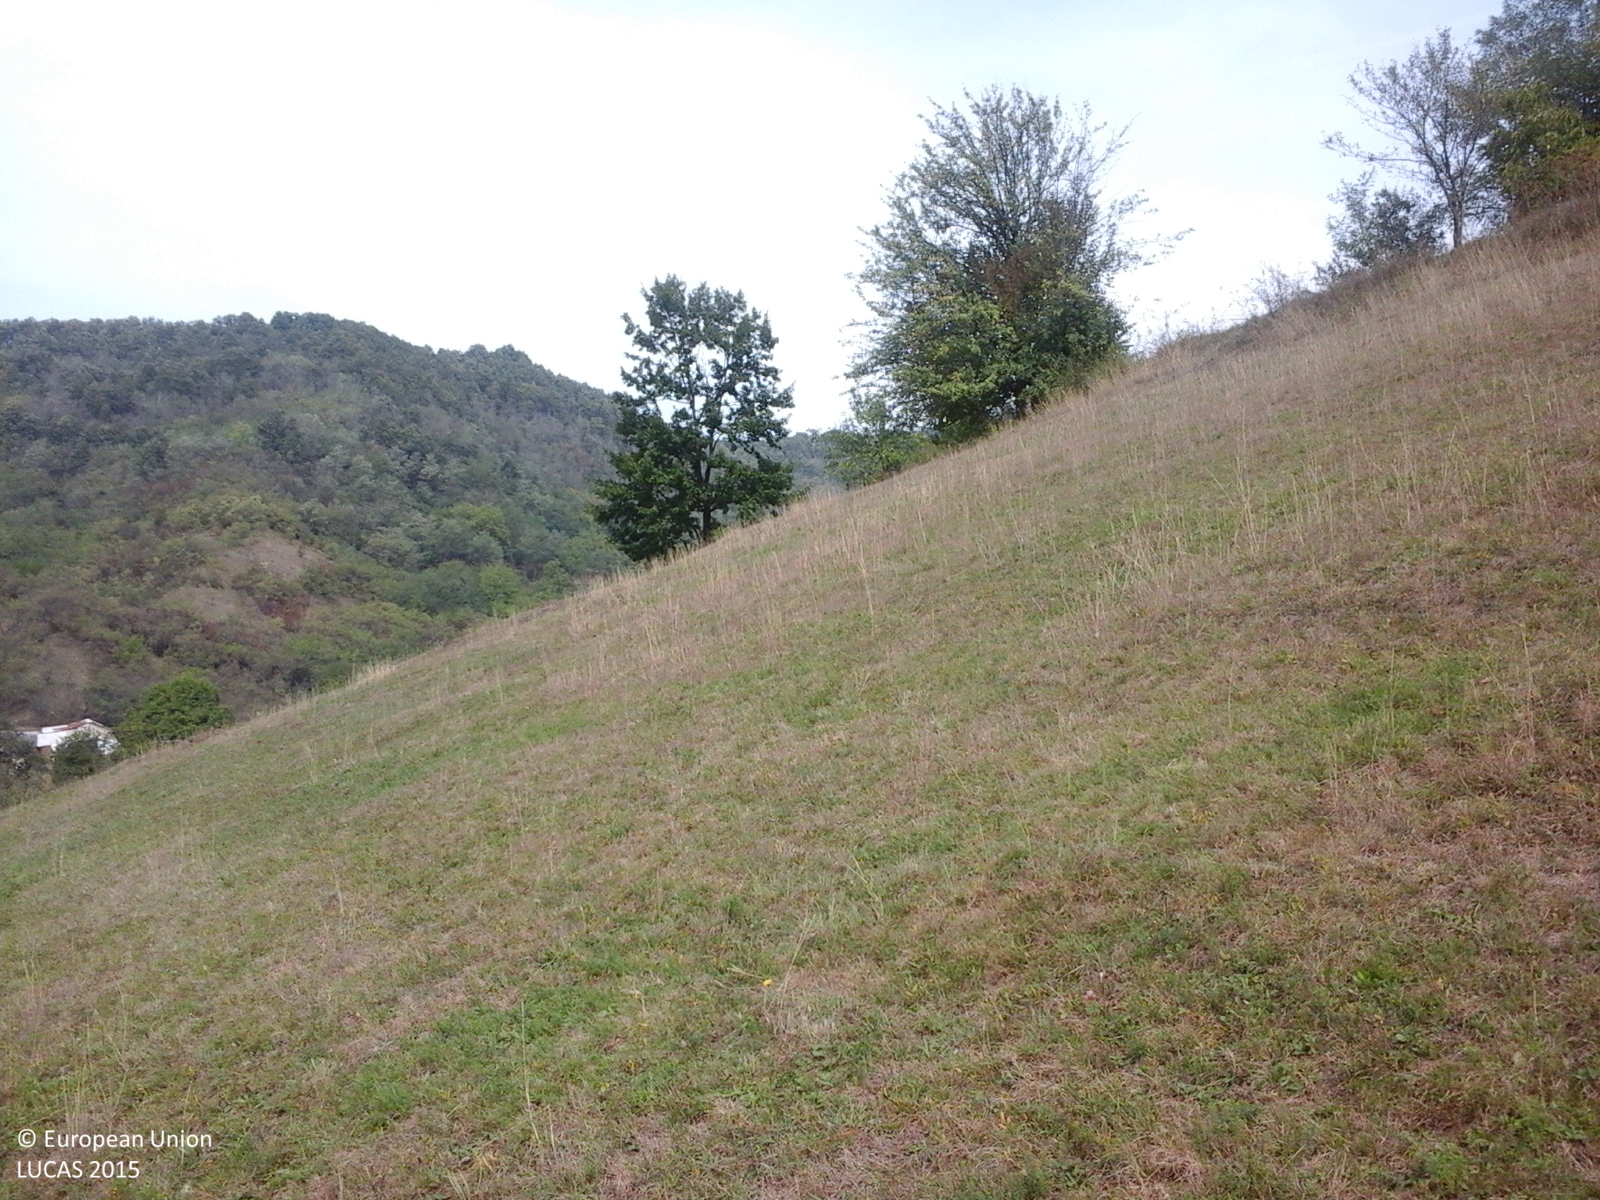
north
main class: Grassland
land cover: Grassland without tree/shrub cover
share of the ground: > 75 %
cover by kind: herbaceous plants 100 %
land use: Agriculture (excluding fallow land and kitchen gardens)
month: September
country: RO
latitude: 47.1164
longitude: 23.3407
